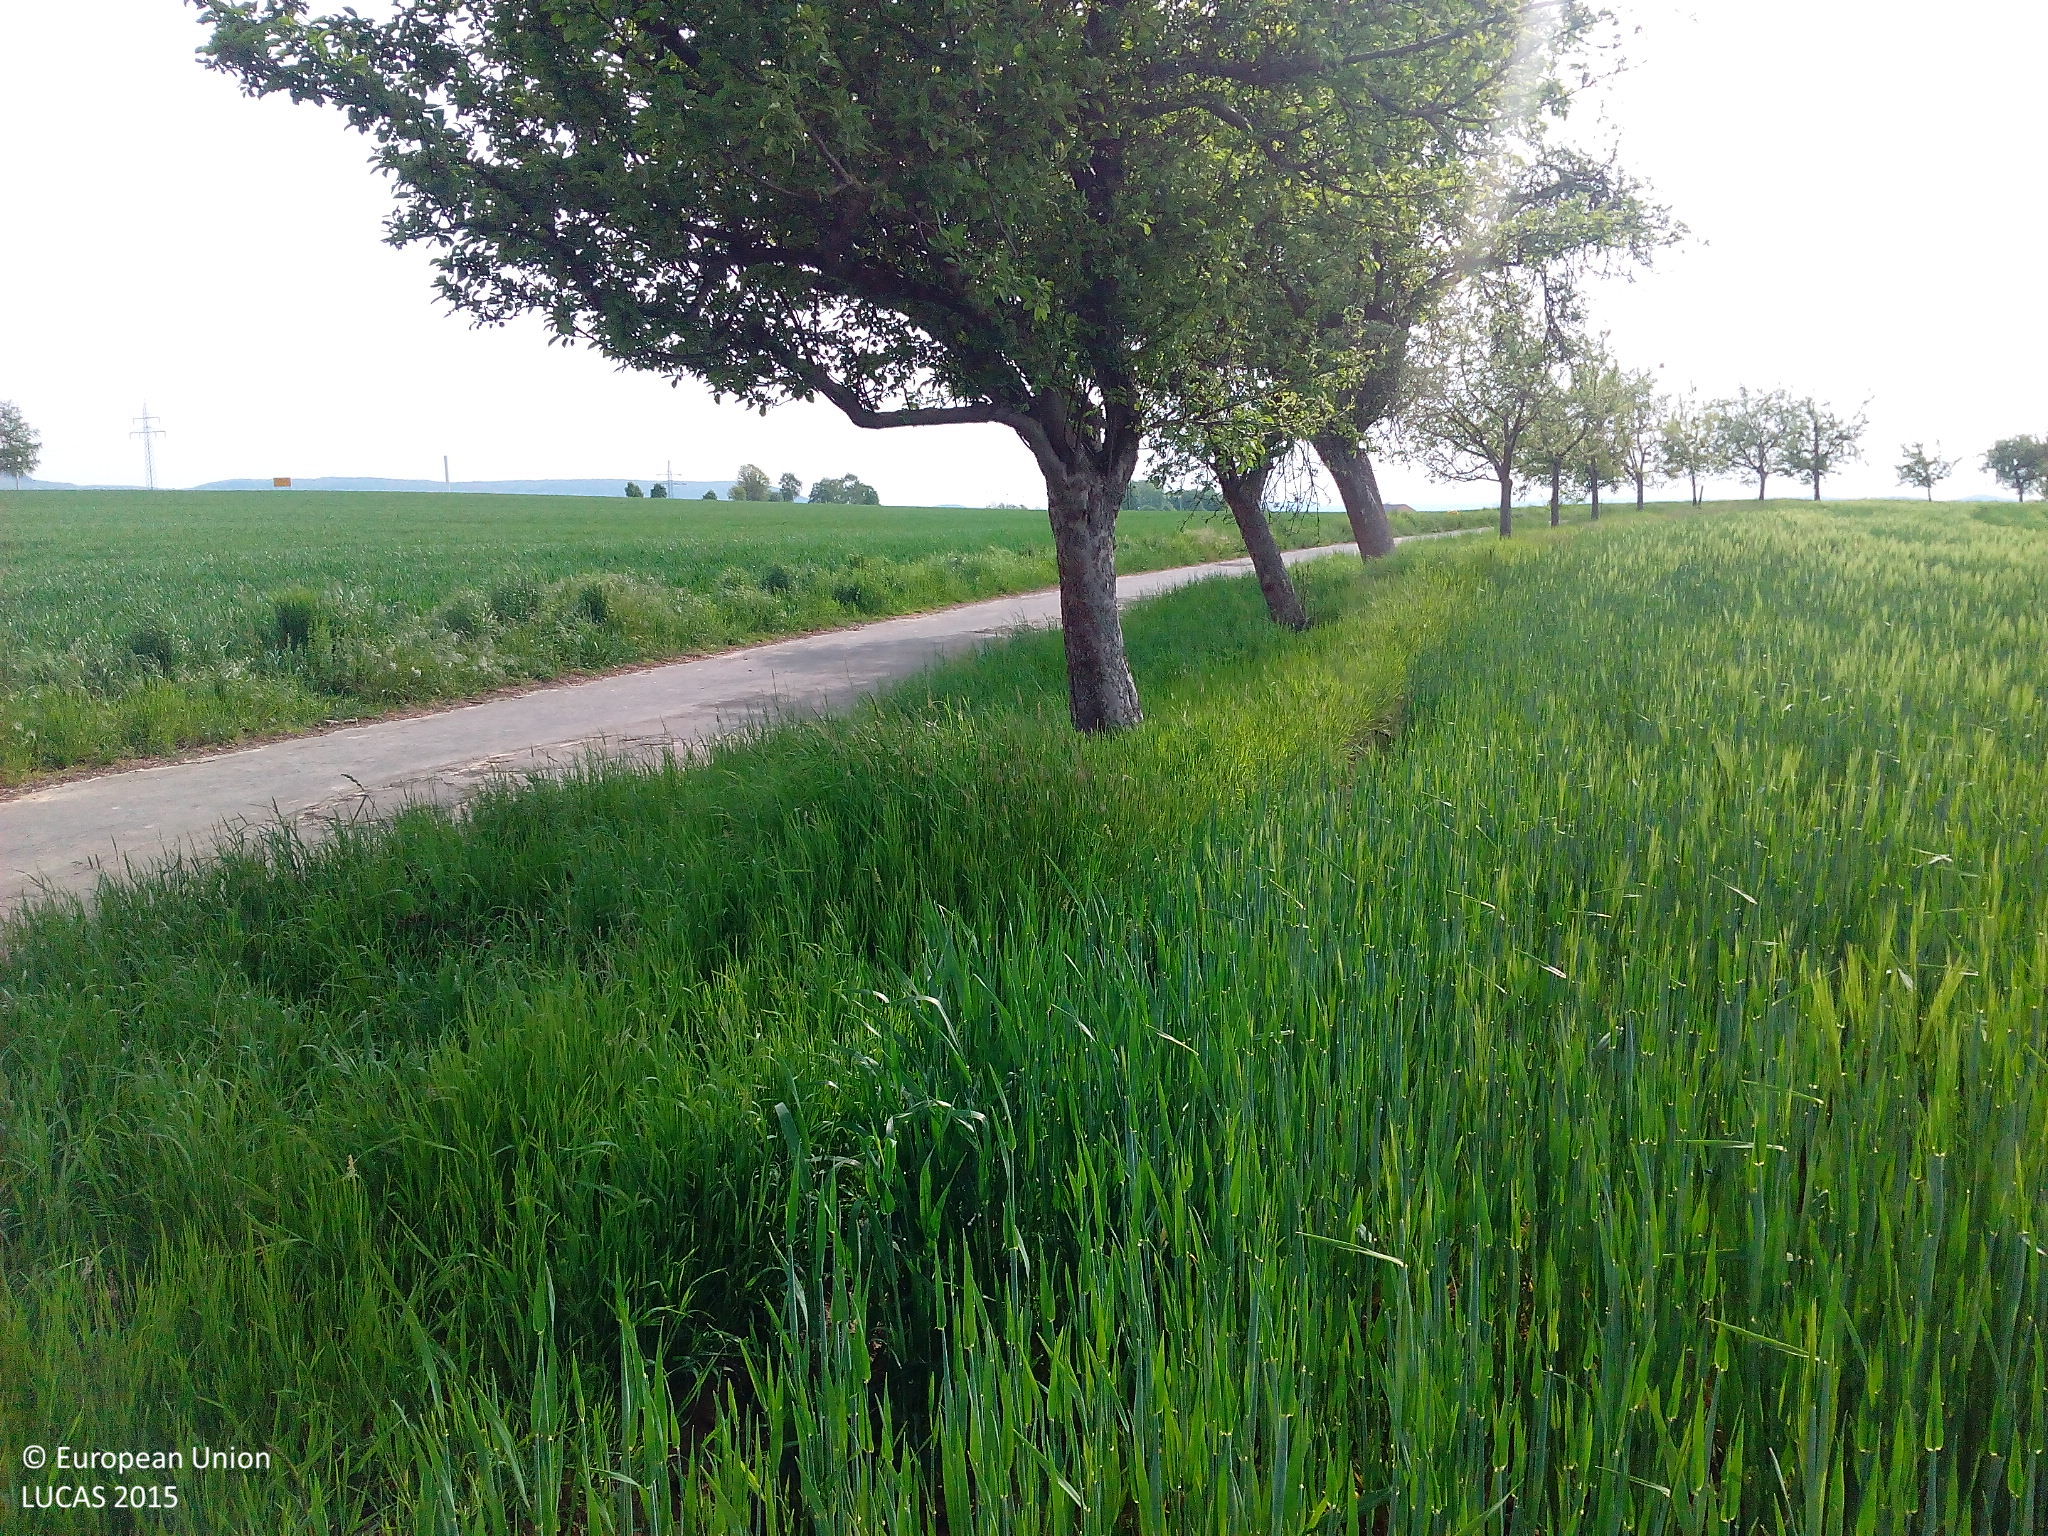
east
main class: Cropland
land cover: Barley
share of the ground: > 75 %
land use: Agriculture (excluding fallow land and kitchen gardens)
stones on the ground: < 10 %
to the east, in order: Barley; Lines of trees; Grass margins; Paved roads, cycling and walking lanes; Grass margins; Common wheat; Barley
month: May
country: DE
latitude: 51.2090
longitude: 9.9571
